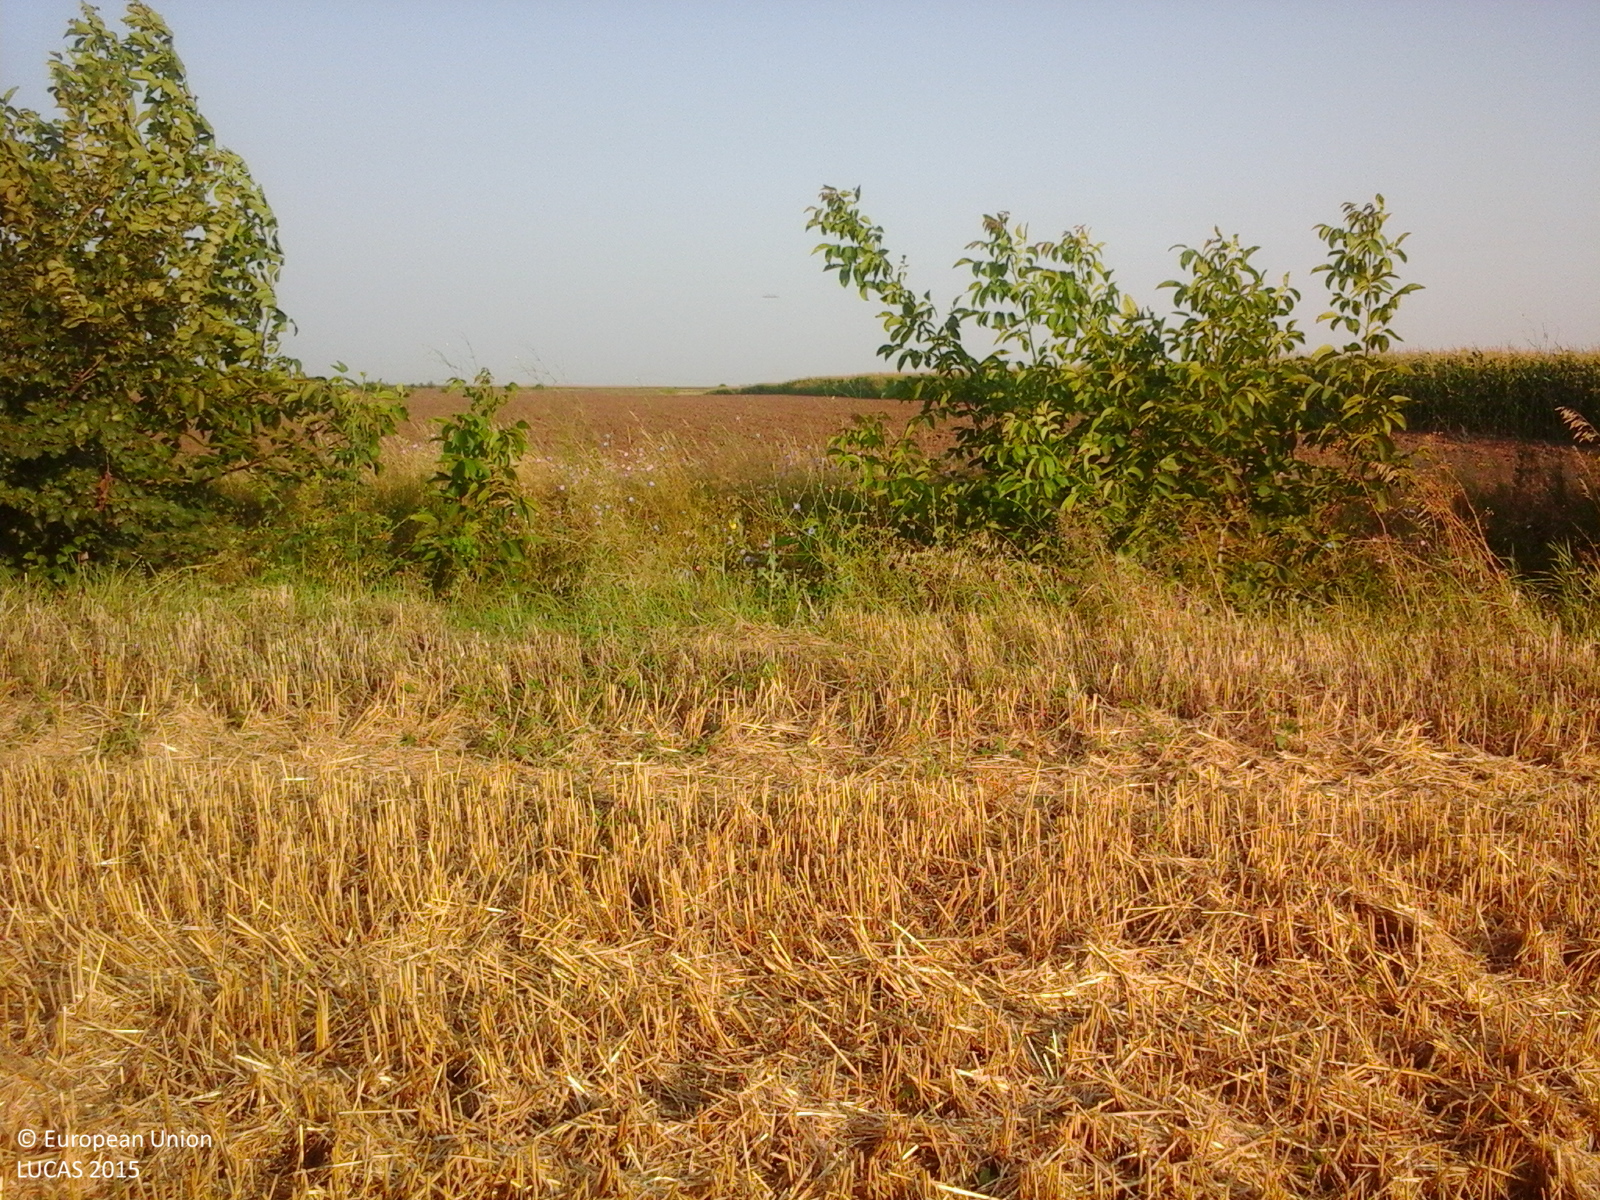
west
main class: Cropland
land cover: Durum wheat
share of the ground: 25 - 50 %
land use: Agriculture (excluding fallow land and kitchen gardens)
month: July
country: RO
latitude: 44.5888
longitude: 27.1254
